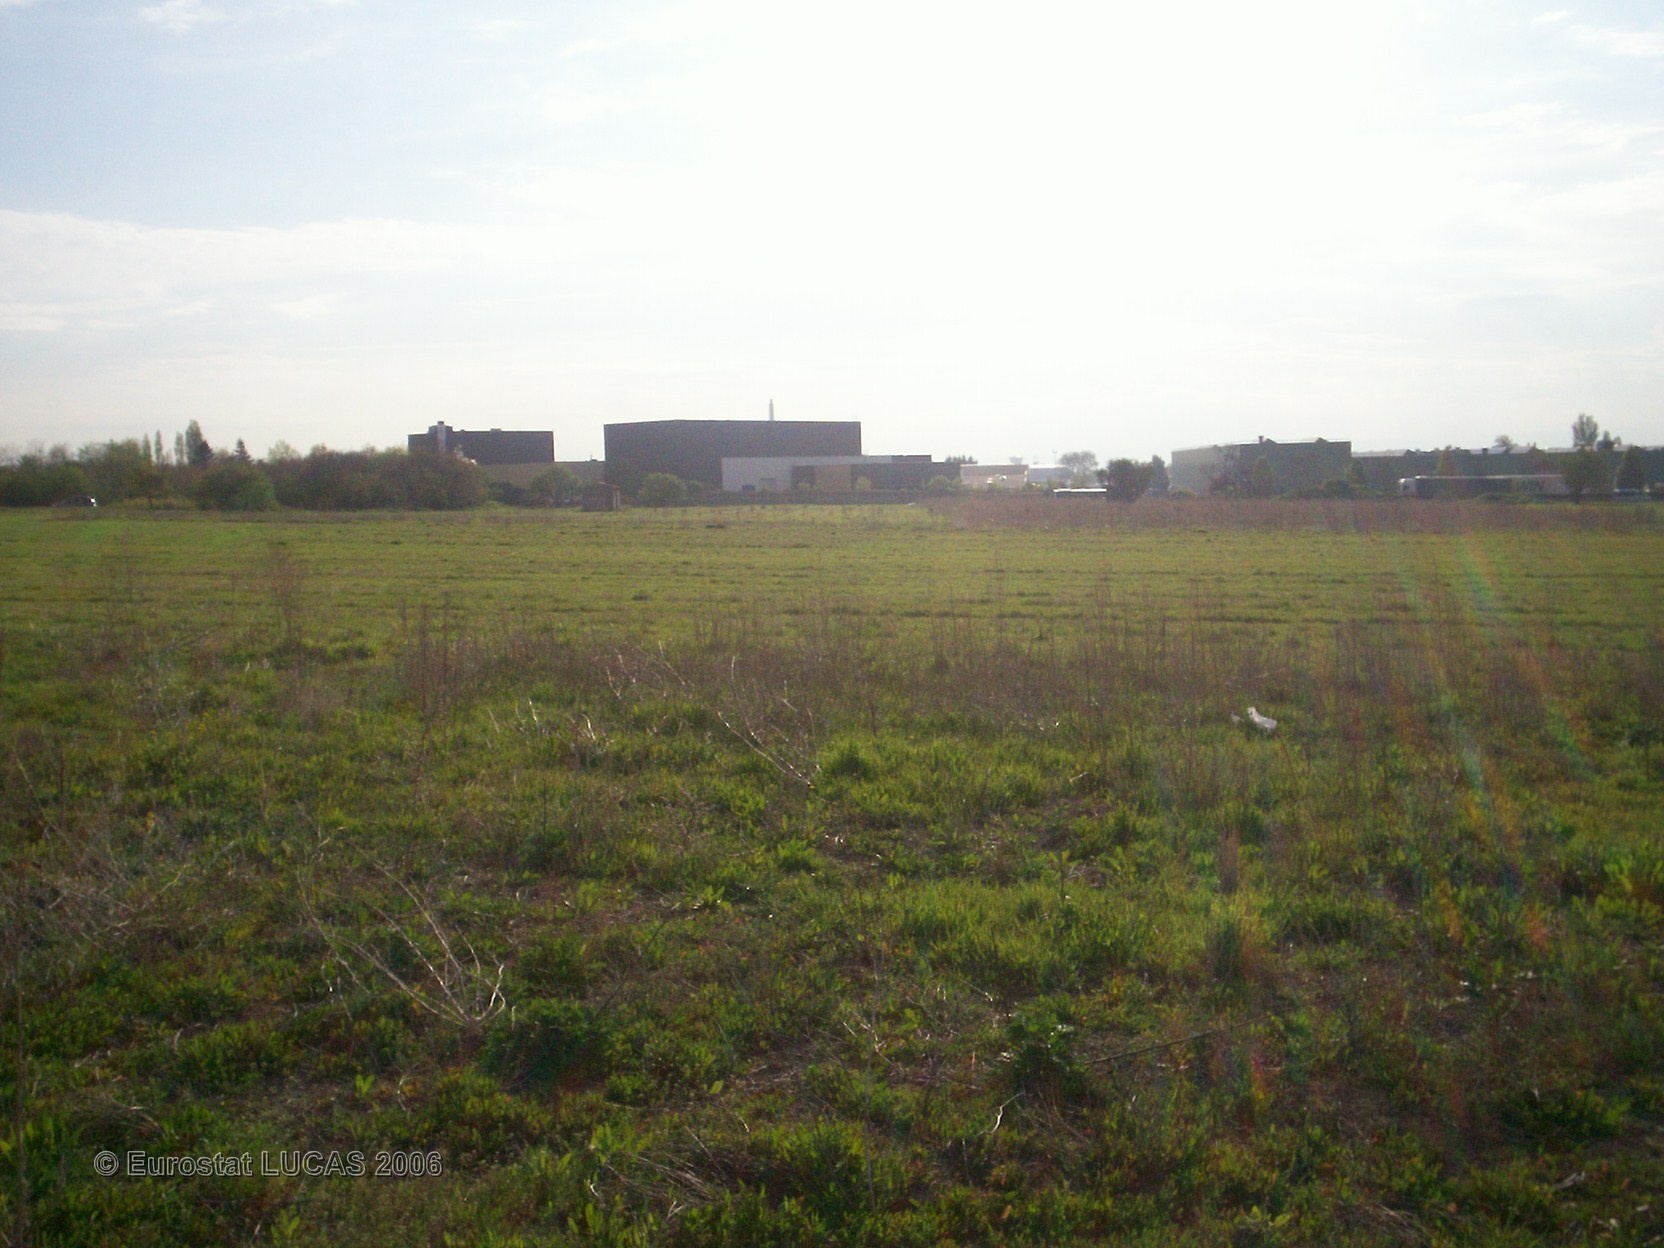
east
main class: Grassland
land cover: Grassland without tree/shrub cover
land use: Fallow land
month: April
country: FR
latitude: 45.8398
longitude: 3.1113
